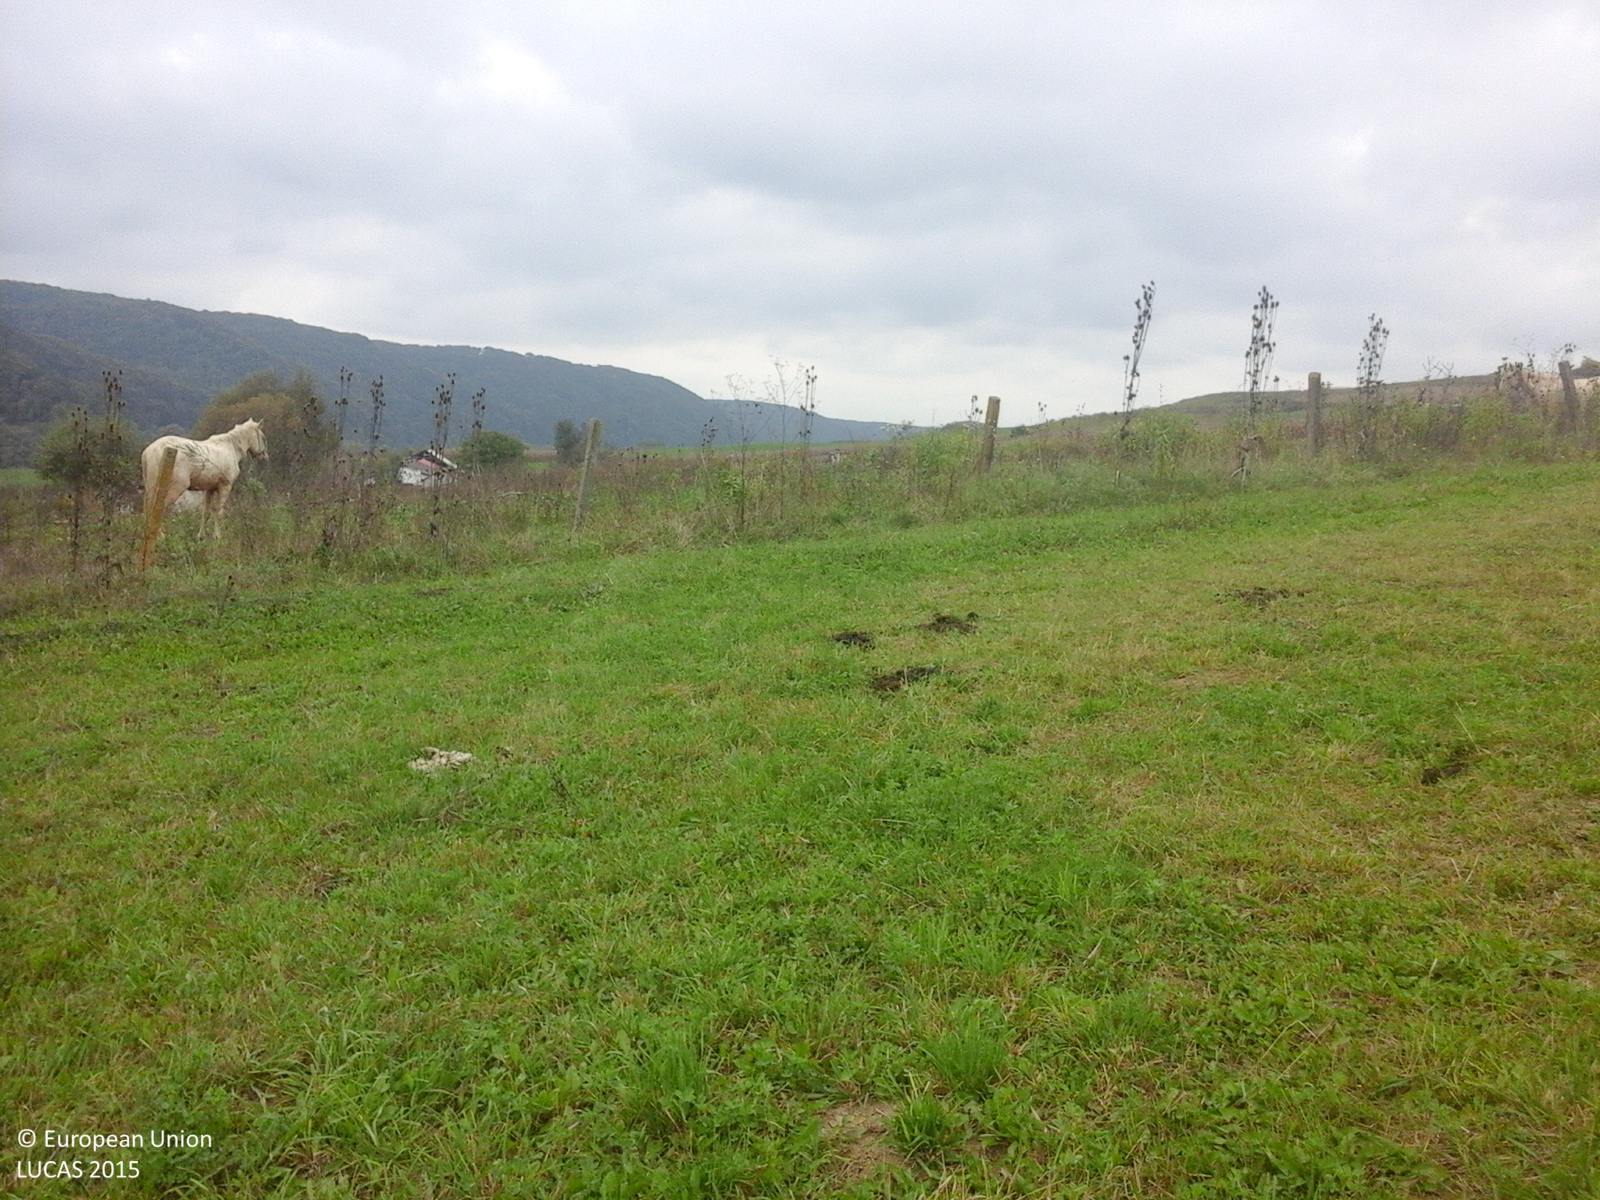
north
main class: Grassland
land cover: Grassland without tree/shrub cover
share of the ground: > 75 %
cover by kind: herbaceous plants 100 %
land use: Agriculture (excluding fallow land and kitchen gardens)
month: October
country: RO
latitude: 46.1616
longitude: 24.7624
